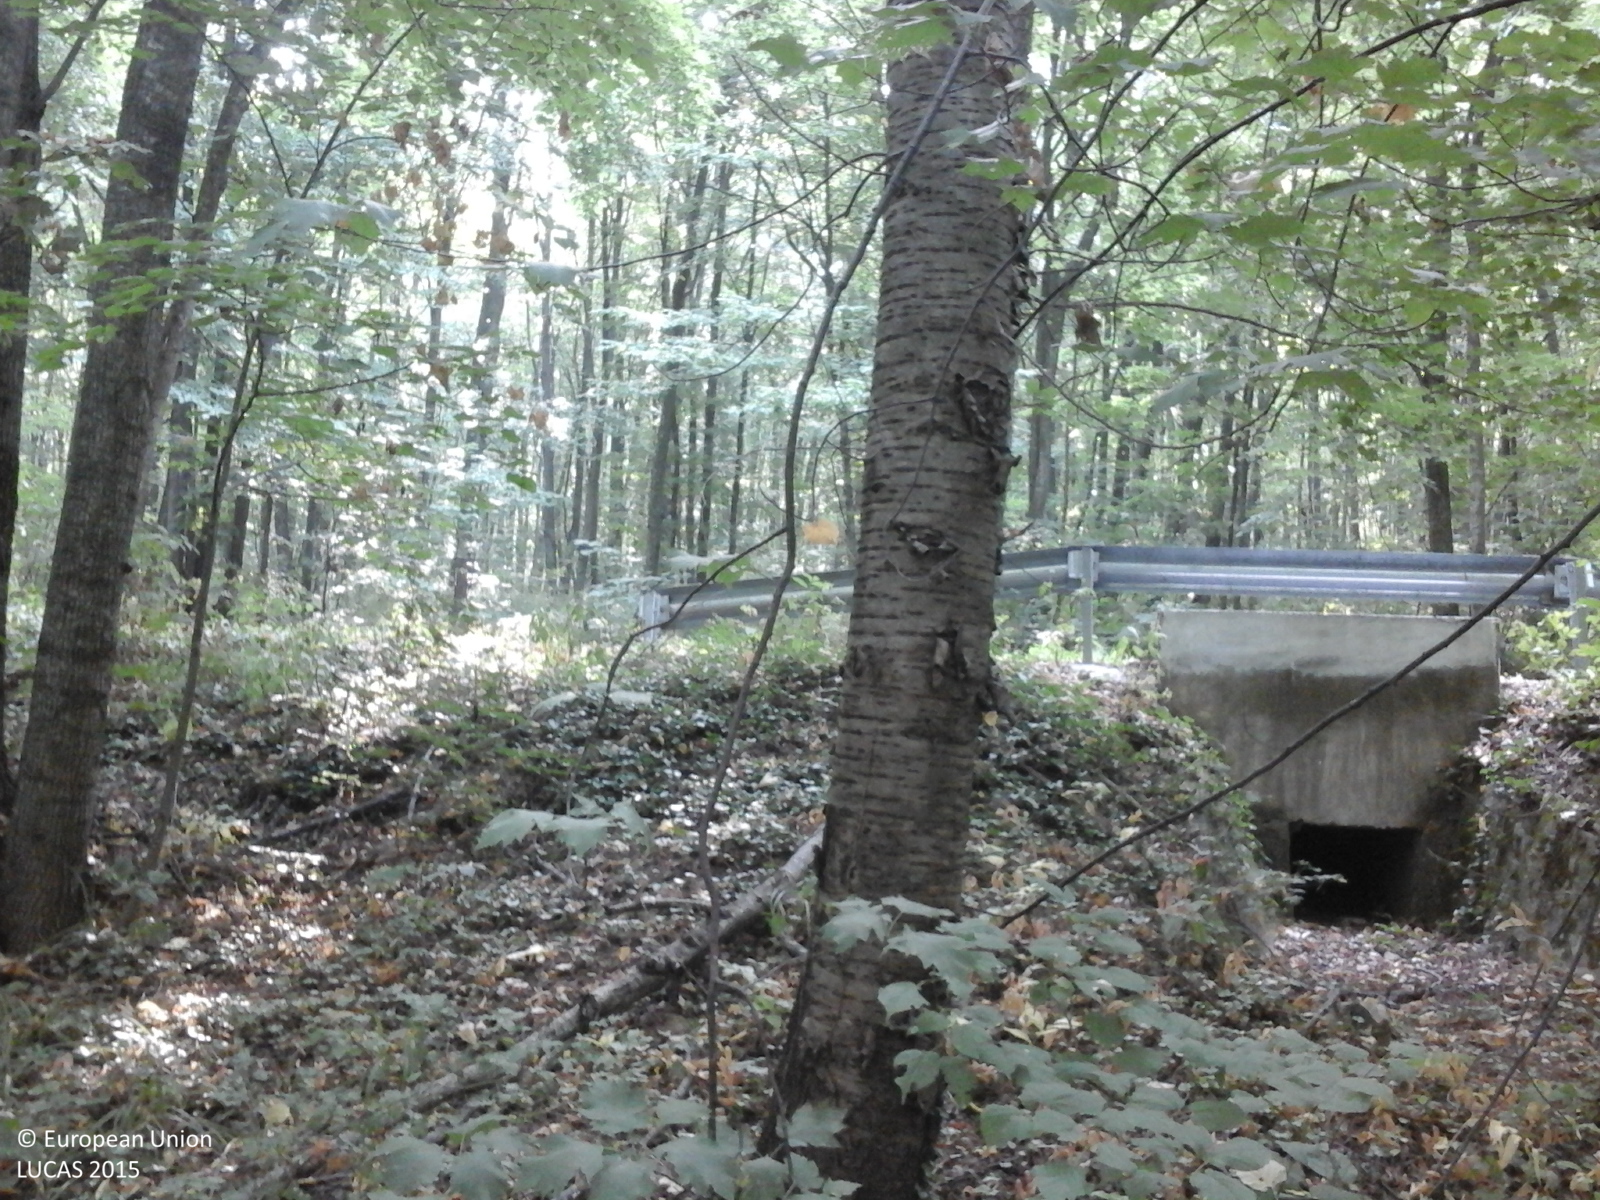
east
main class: Woodland
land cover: Broadleaved woodland
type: mesophytic deciduous forest
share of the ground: > 75 %
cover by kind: broadleaved forest trees 100 %
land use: Forestry
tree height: > 5 m
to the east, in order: Broadleaved woodland; Paved roads, cycling and walking lanes; Ditches and canals; Broadleaved woodland; Tracks; Broadleaved woodland
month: July
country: RO
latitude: 45.2124
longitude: 28.3206
